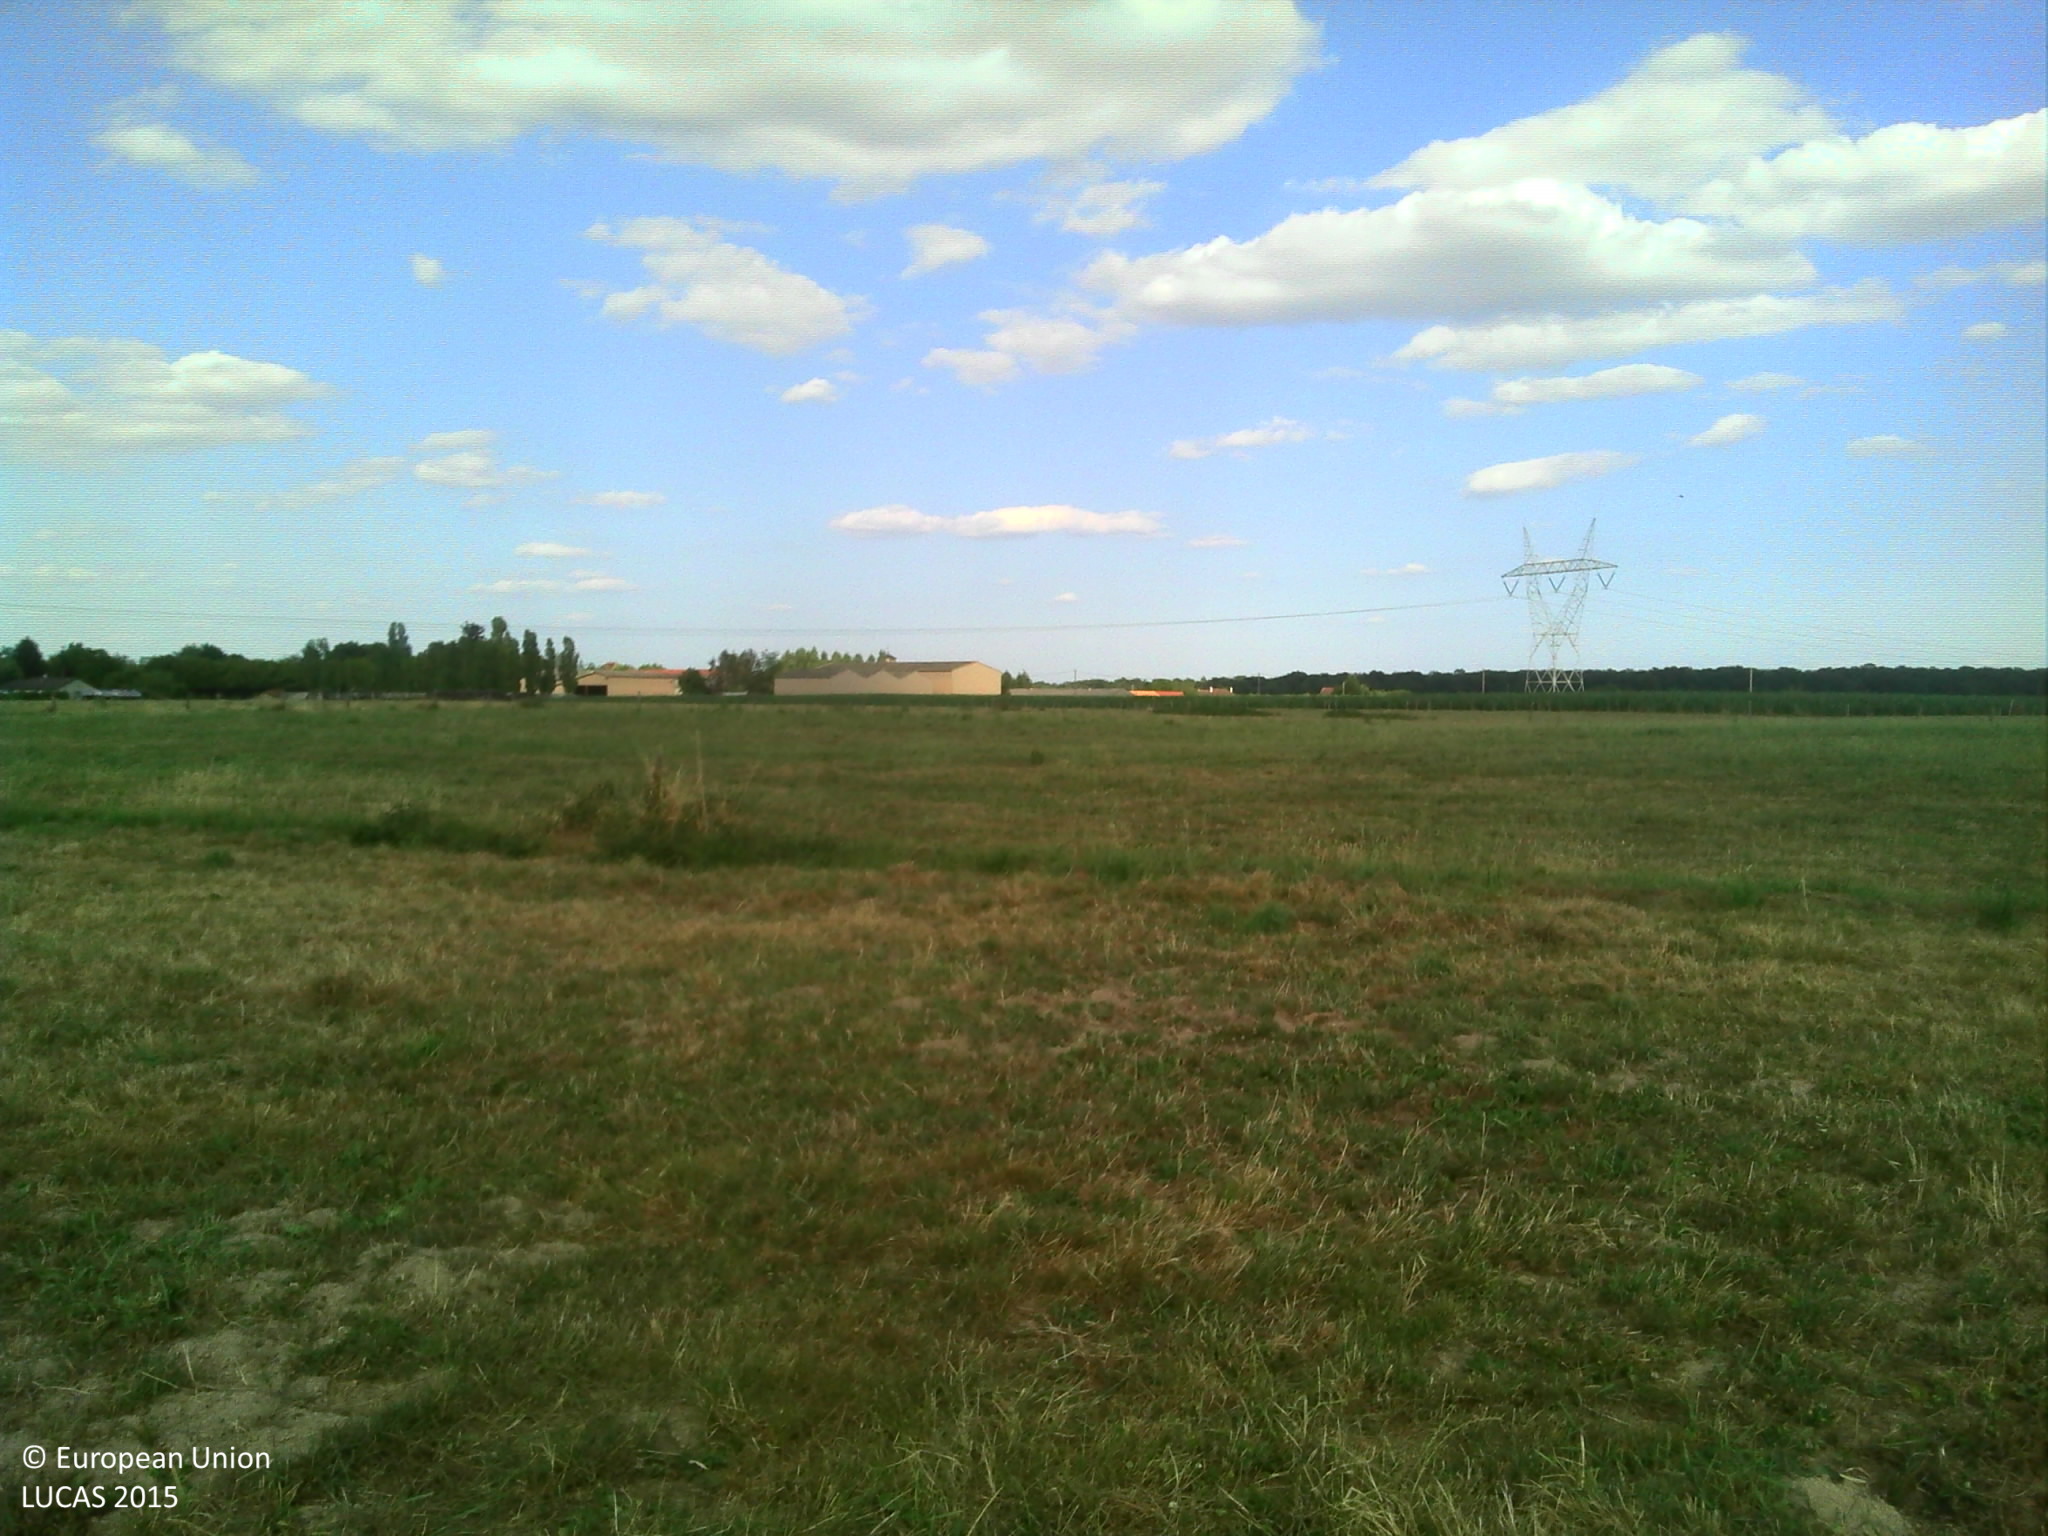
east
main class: Grassland
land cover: Grassland without tree/shrub cover
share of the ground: > 75 %
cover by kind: herbaceous plants 100 %
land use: Agriculture (excluding fallow land and kitchen gardens)
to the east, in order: Grassland without tree/shrub cover; Fences; Tracks; Fences; Grassland without tree/shrub cover; Fences; Tracks; Fences; Maize
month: July
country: FR
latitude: 46.8516
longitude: 5.0834
